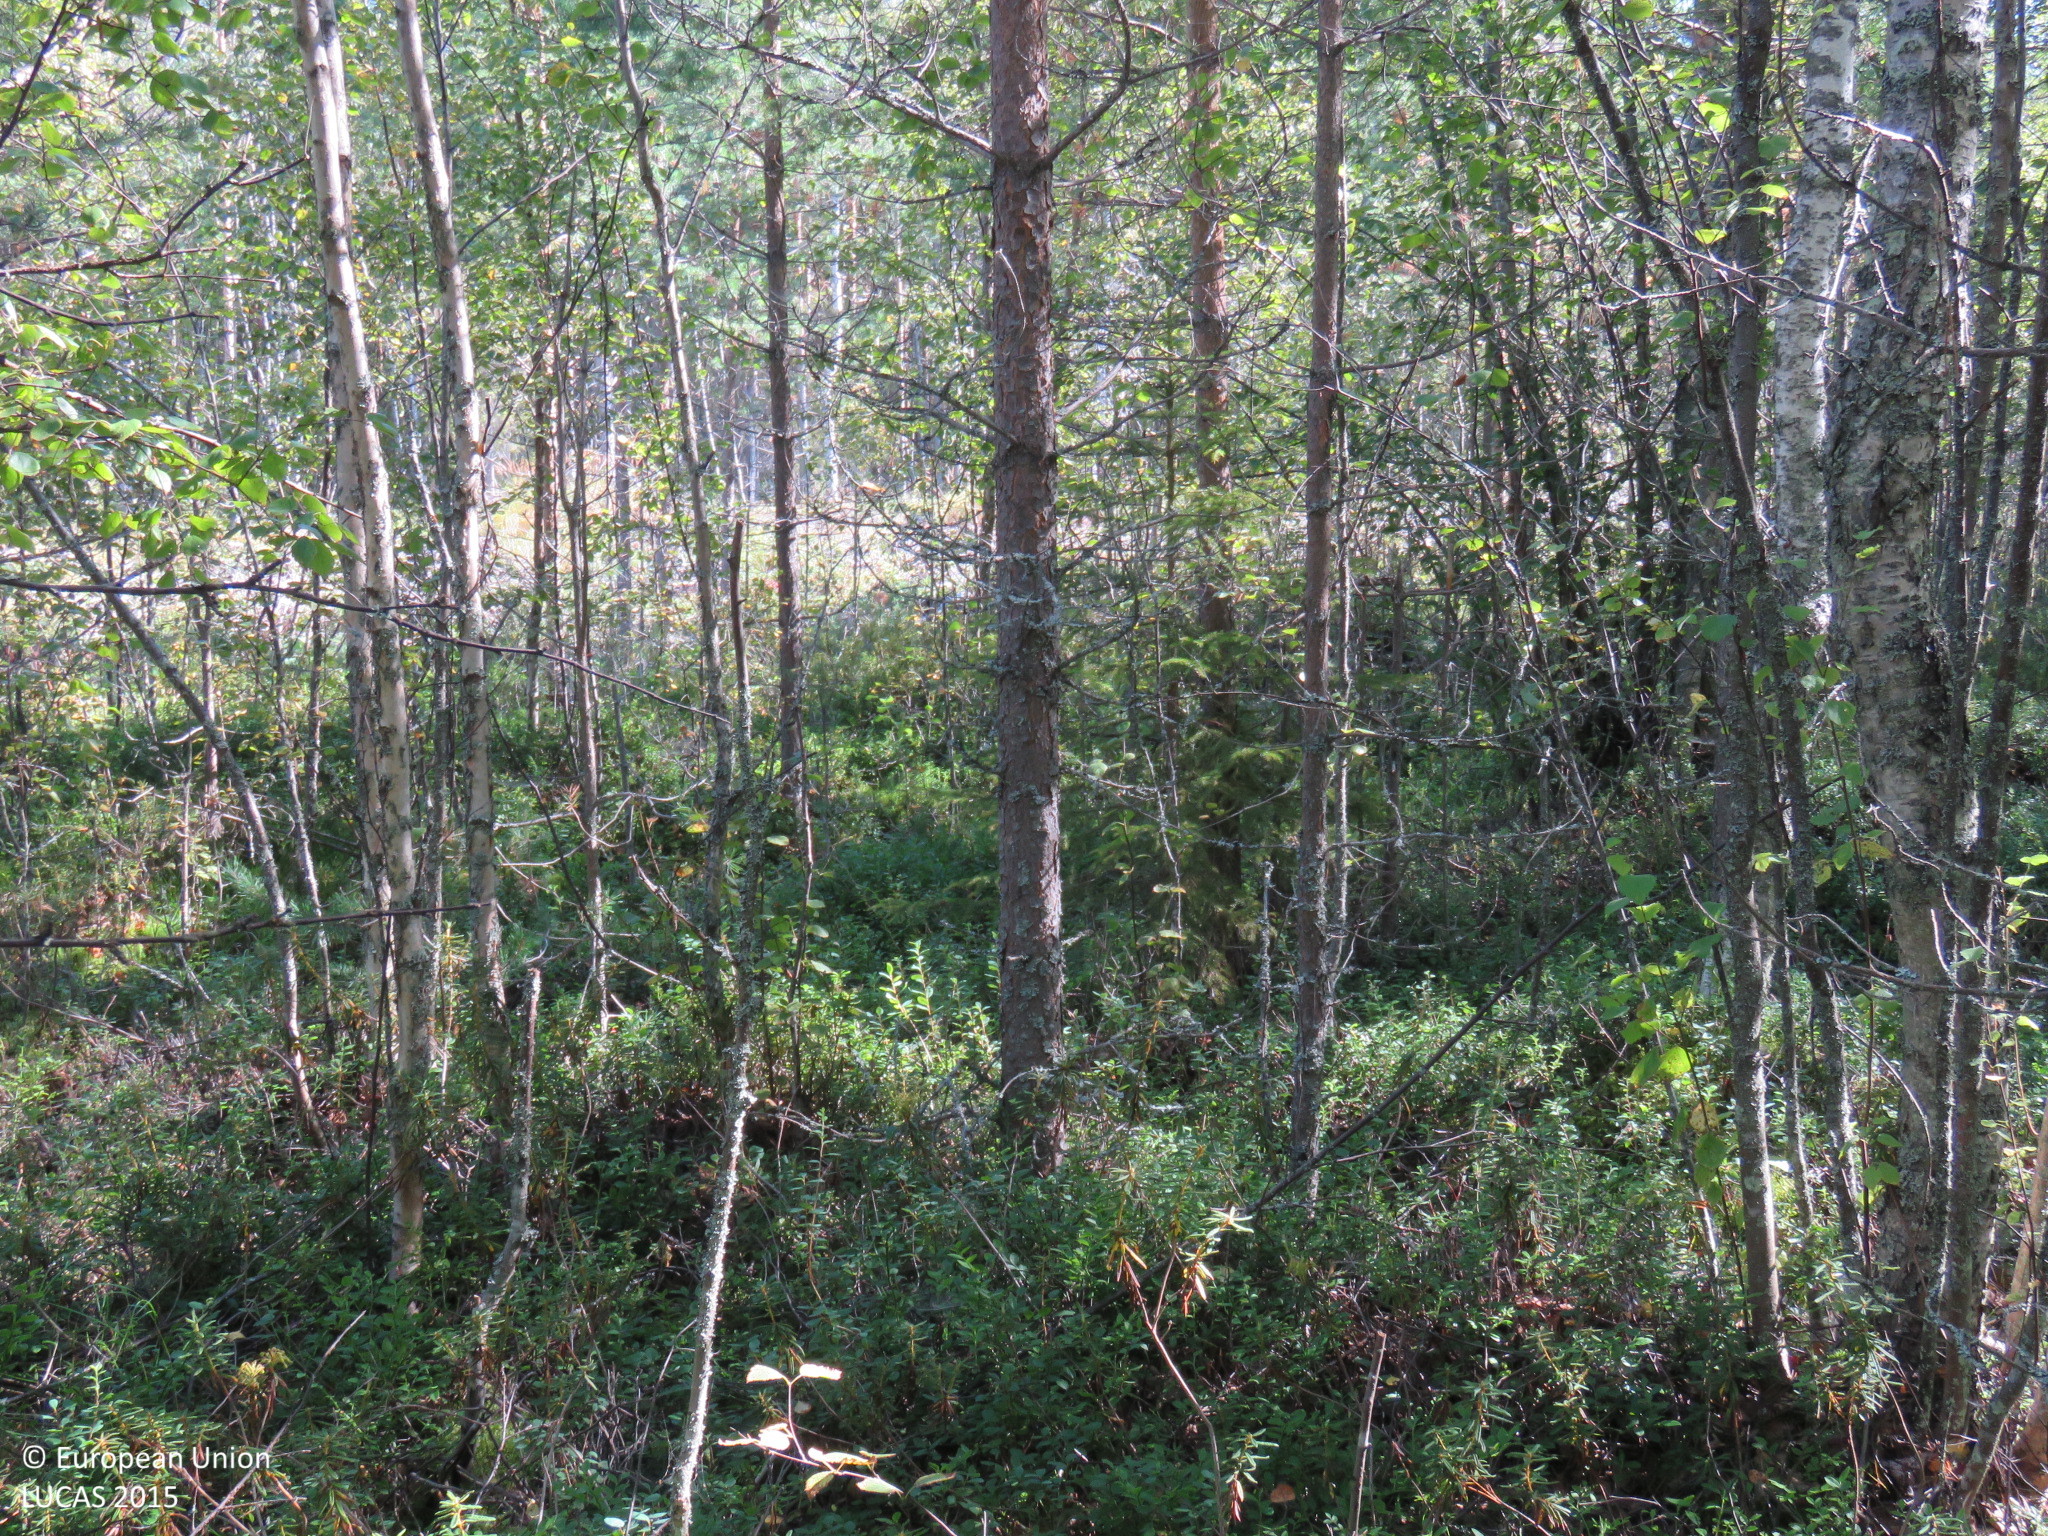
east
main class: Woodland
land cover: Pine dominated mixed woodland
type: boreal forest
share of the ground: > 75 %
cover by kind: broadleaved forest trees 55 %, coniferous forest trees 40 %, shrubs 5 %
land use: Forestry
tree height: > 5 m
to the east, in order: Pine dominated mixed woodland; Other mixed woodland; Ditches and canals; Other coniferous woodland; Shrubland with sparse tree cover; Ditches and canals; Other mixed woodland; Other coniferous woodland; Ditches and canals; Other mixed woodland; Other coniferous woodland; Ditches and canals; Other mixed woodland; Pine dominated mixed woodland
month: August
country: FI
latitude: 64.9866
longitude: 24.8438
